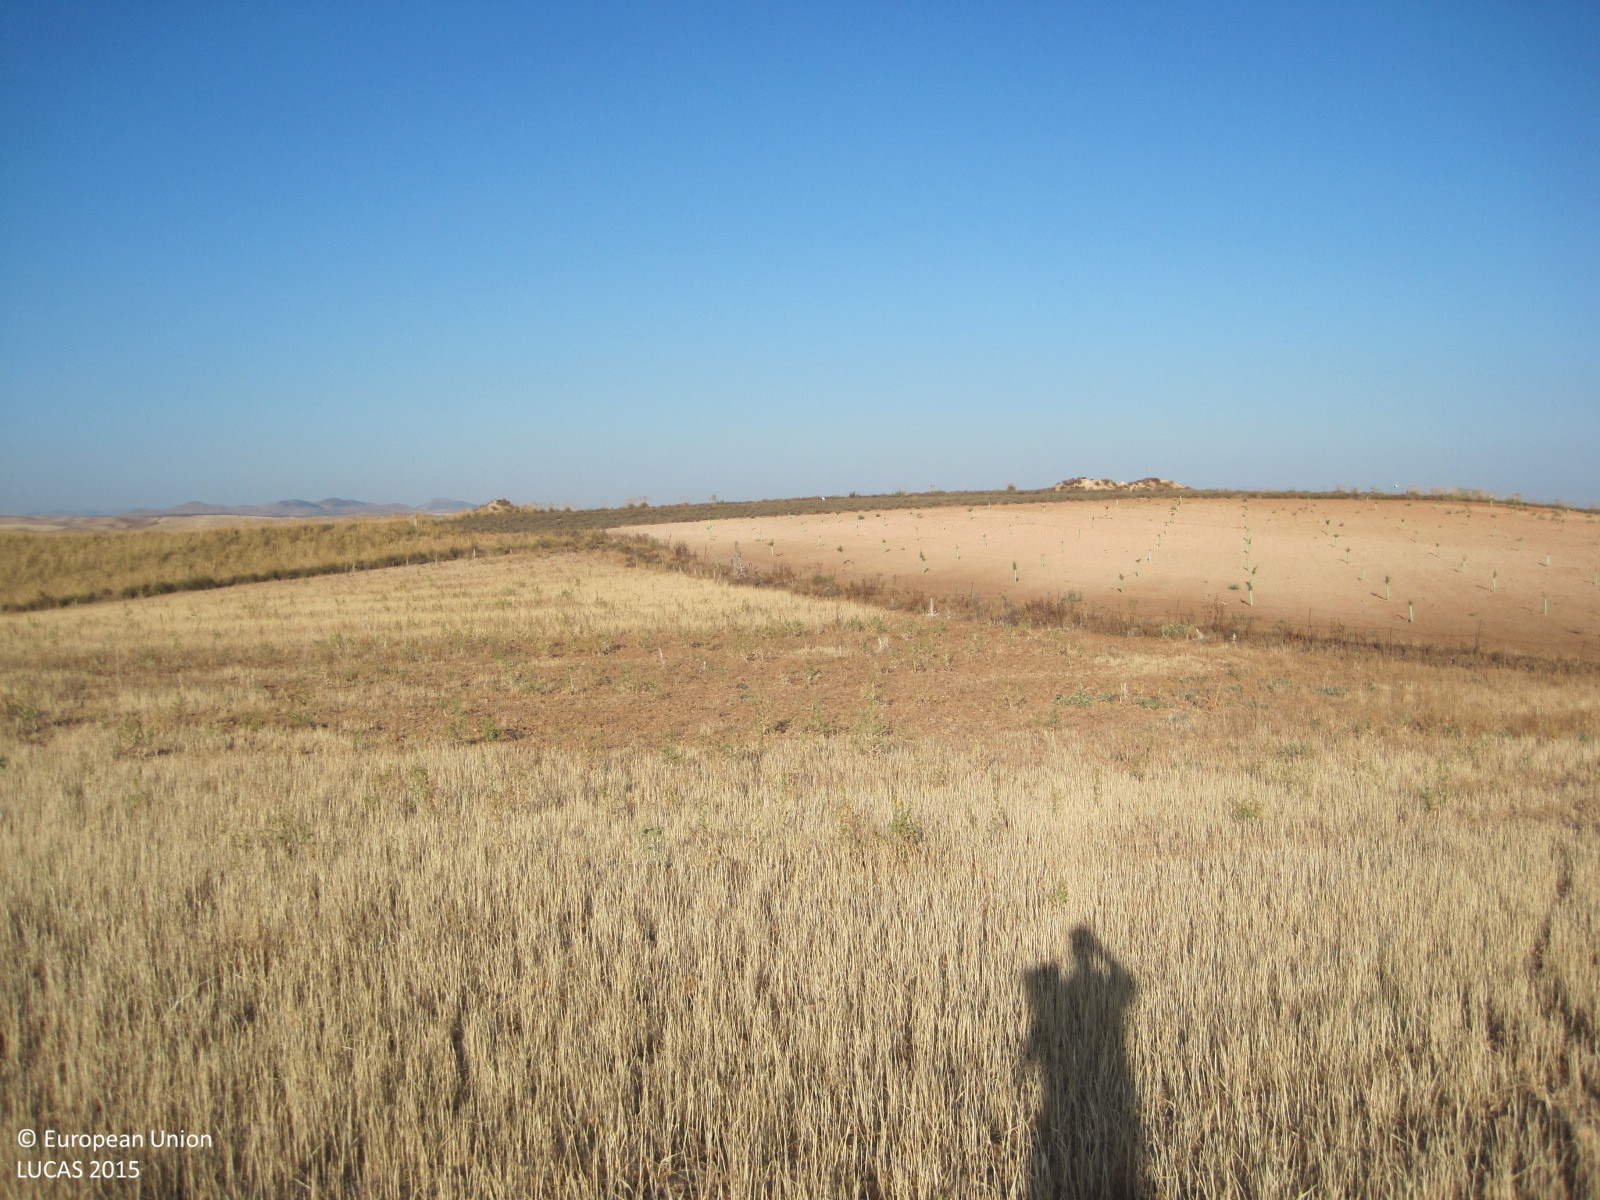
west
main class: Cropland
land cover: Barley
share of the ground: < 10 %
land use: Agriculture (excluding fallow land and kitchen gardens)
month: July
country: ES
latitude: 39.8711
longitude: -3.8158
